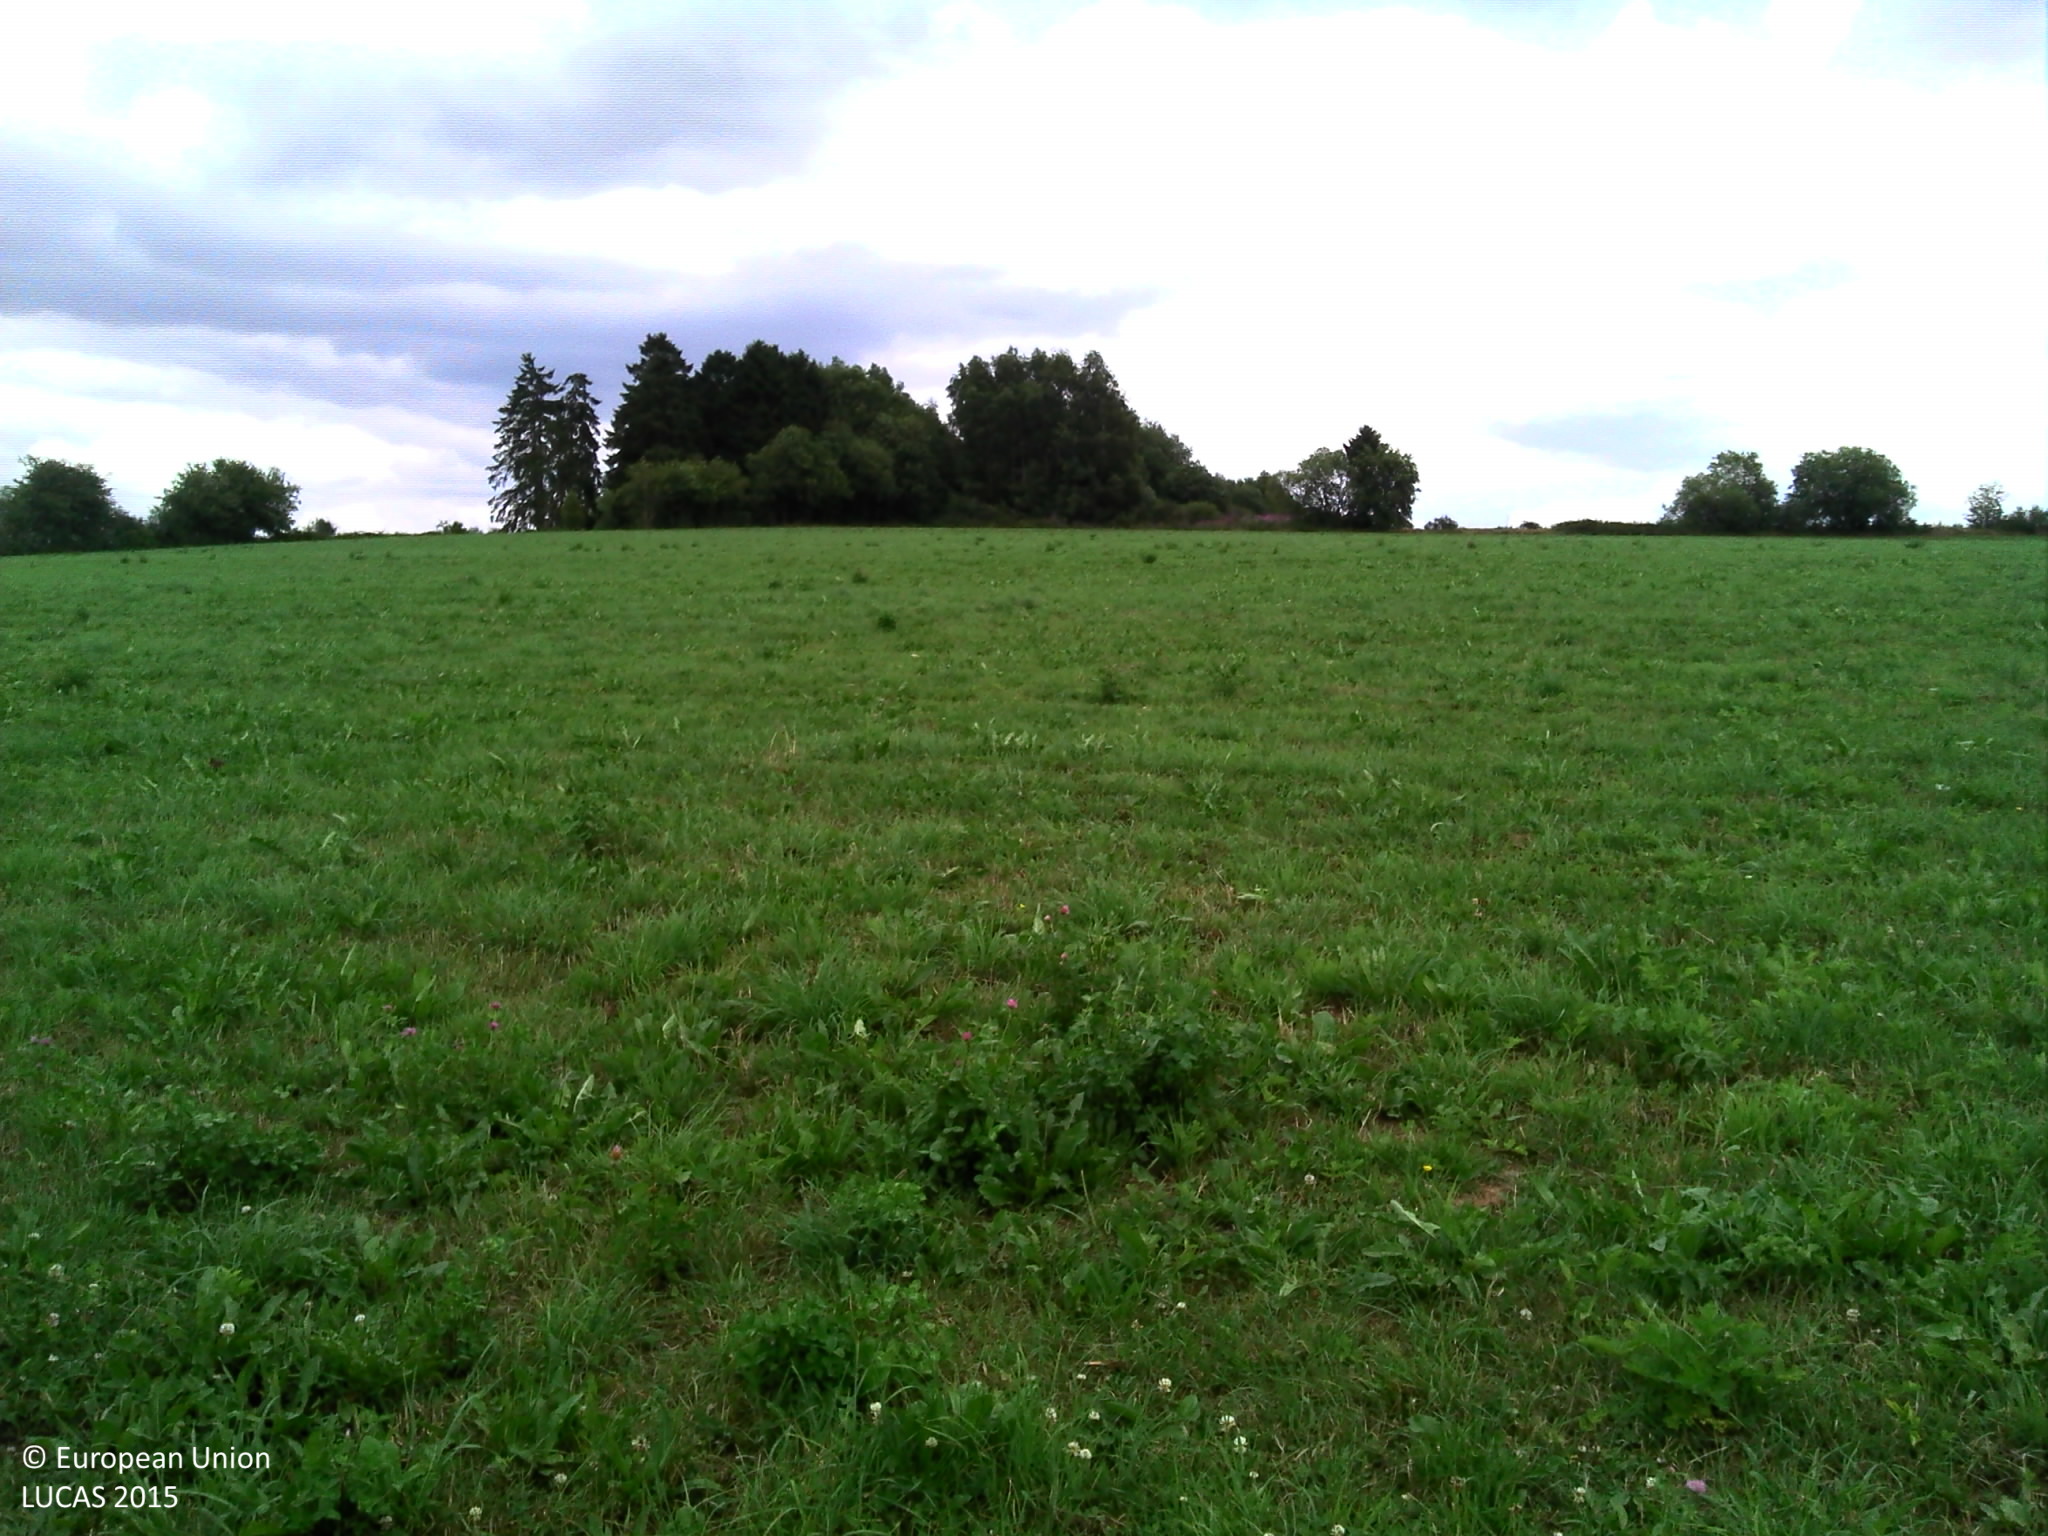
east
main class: Grassland
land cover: Grassland without tree/shrub cover
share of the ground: > 75 %
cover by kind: herbaceous plants 100 %
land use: Residential
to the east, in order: Managed hedges; Grassland without tree/shrub cover; Broadleaved woodland; Tracks; Broadleaved woodland
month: July
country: BE
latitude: 49.7761
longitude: 5.6244
